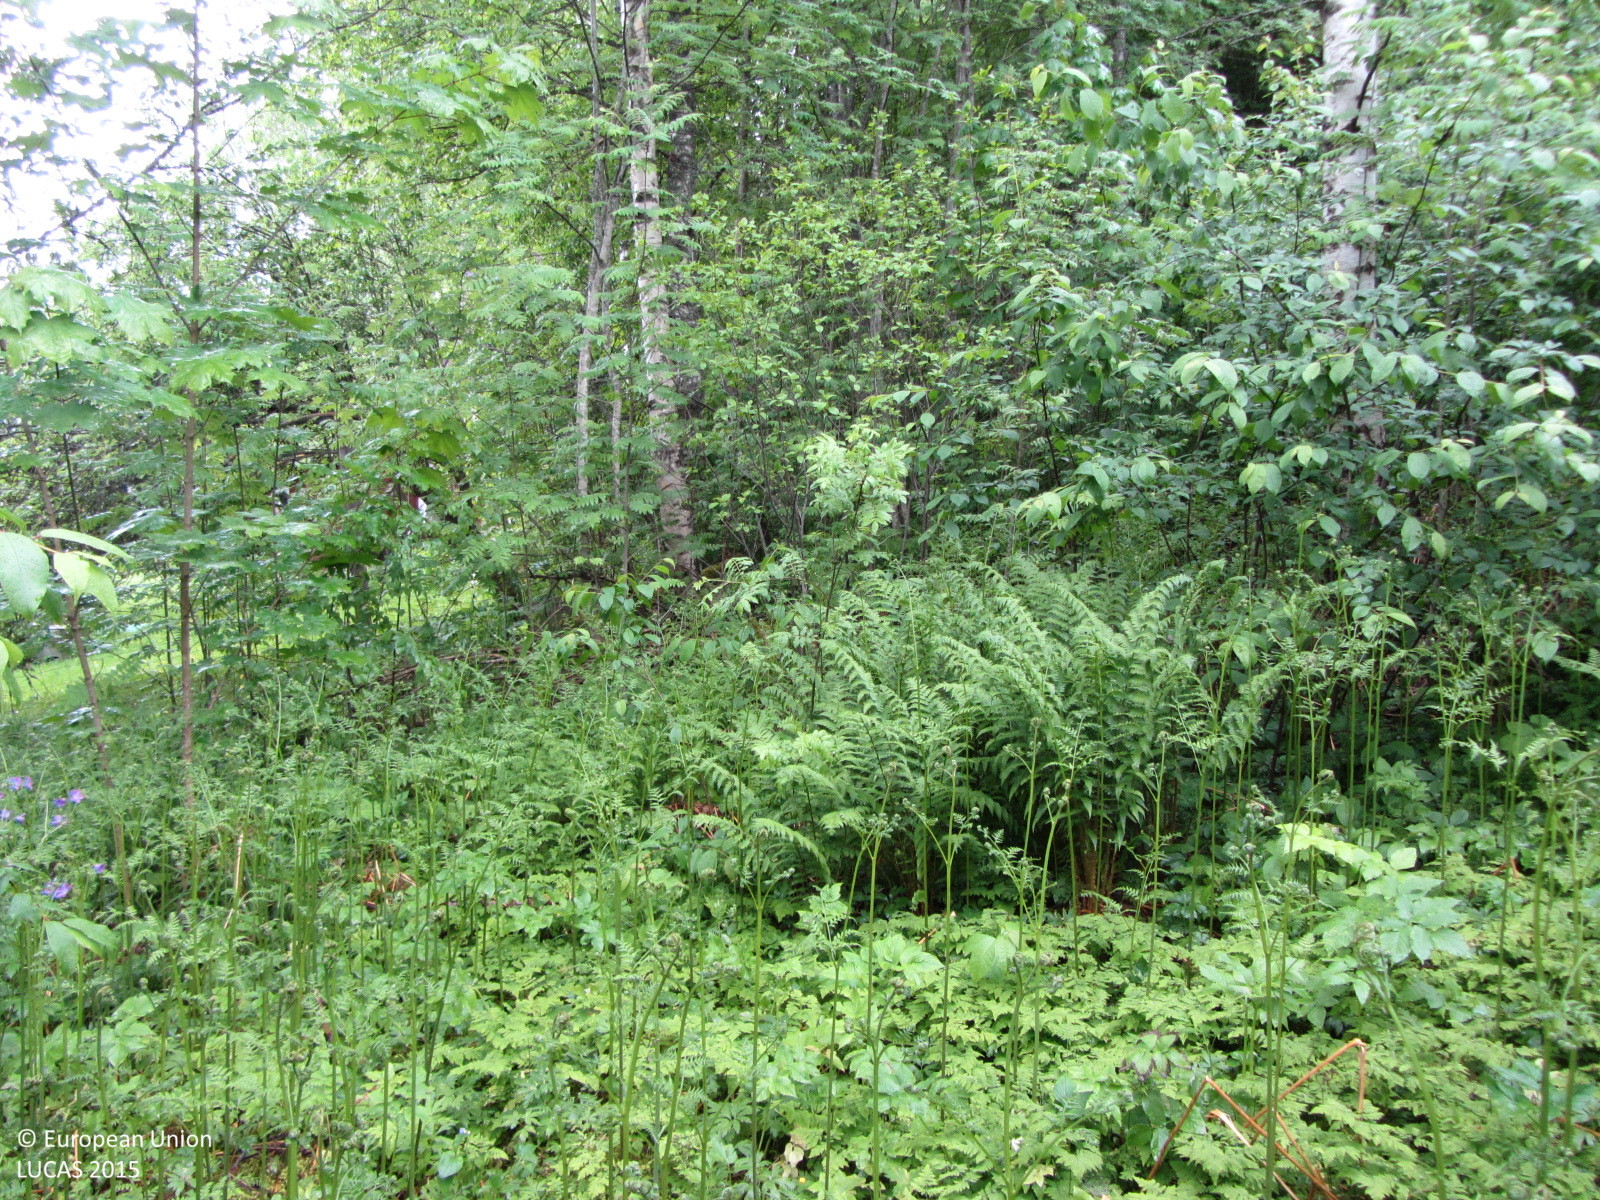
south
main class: Woodland
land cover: Other mixed woodland
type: boreal forest
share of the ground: 50 - 75 %
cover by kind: broadleaved forest trees 40 %, herbaceous plants 35 %, coniferous forest trees 25 %
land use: Forestry
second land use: Residential
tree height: > 5 m
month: June
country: FI
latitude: 60.4327
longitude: 24.7000
